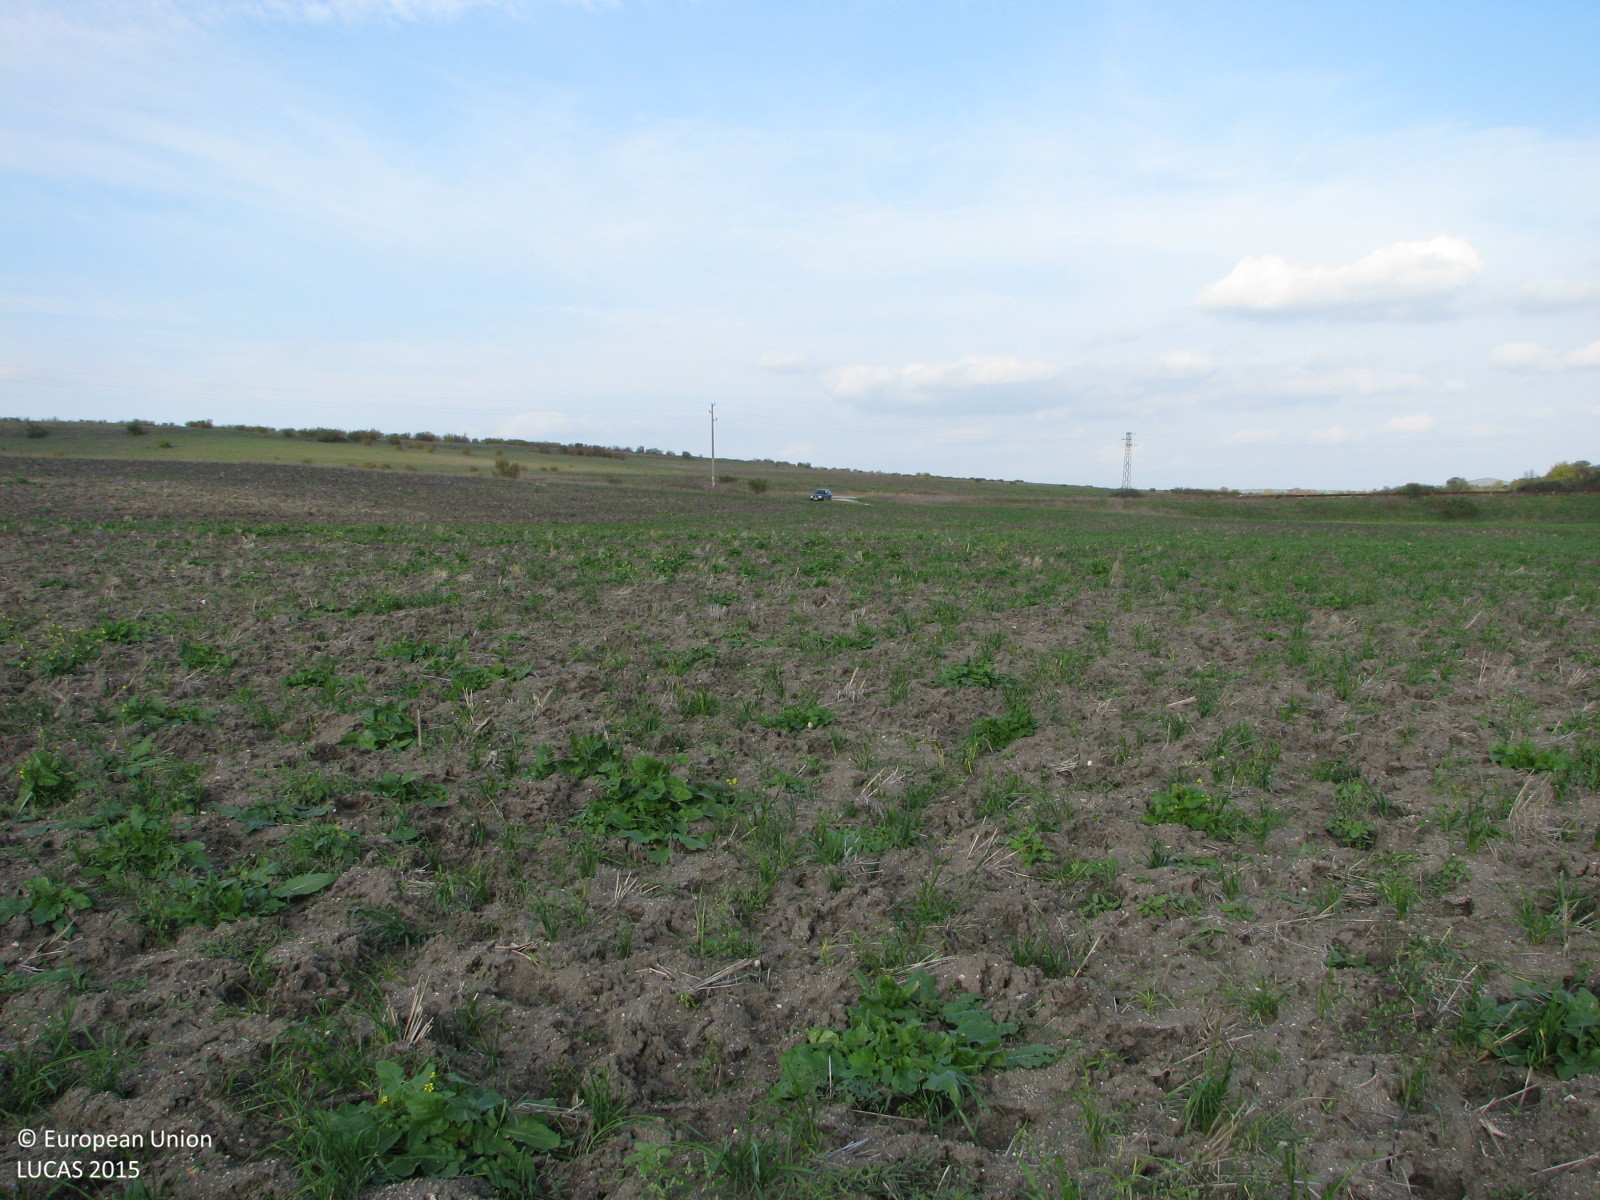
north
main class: Grassland
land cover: Spontaneously vegetated surfaces
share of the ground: 25 - 50 %
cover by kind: unconsolidated bare surface 65 %, herbaceous plants 35 %
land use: Agriculture (excluding fallow land and kitchen gardens)
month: October
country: BG
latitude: 42.2520
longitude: 26.6868
